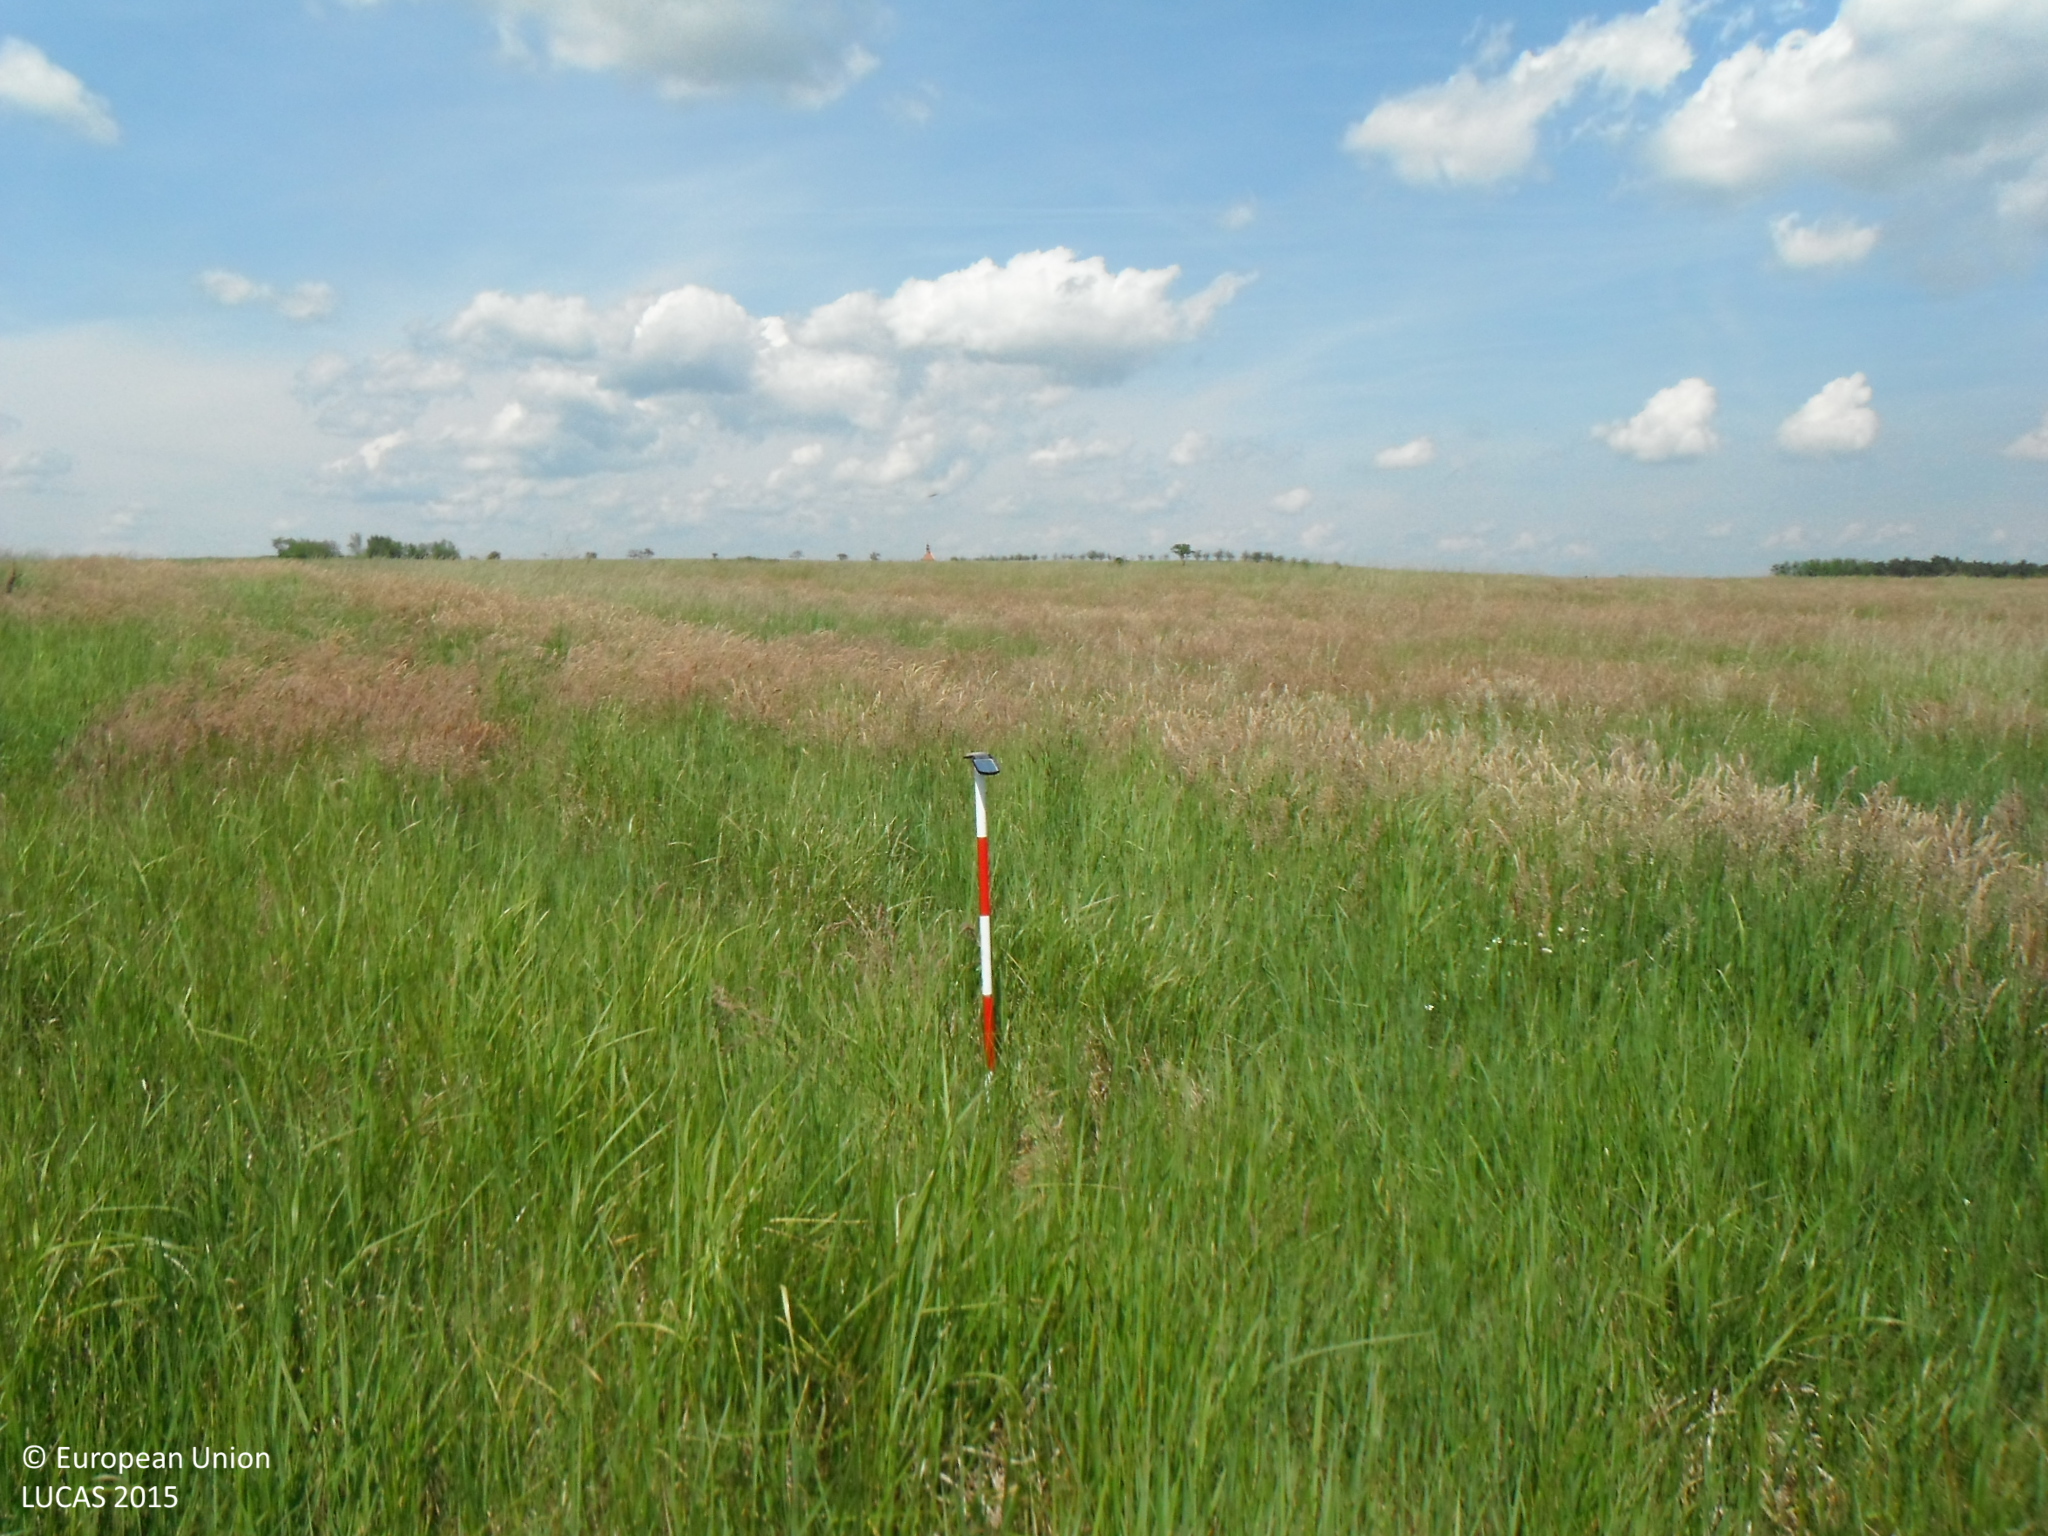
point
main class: Grassland
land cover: Grassland without tree/shrub cover
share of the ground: > 75 %
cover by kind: herbaceous plants 100 %
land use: Agriculture (excluding fallow land and kitchen gardens)
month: June
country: SK
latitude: 48.5940
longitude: 17.0455
